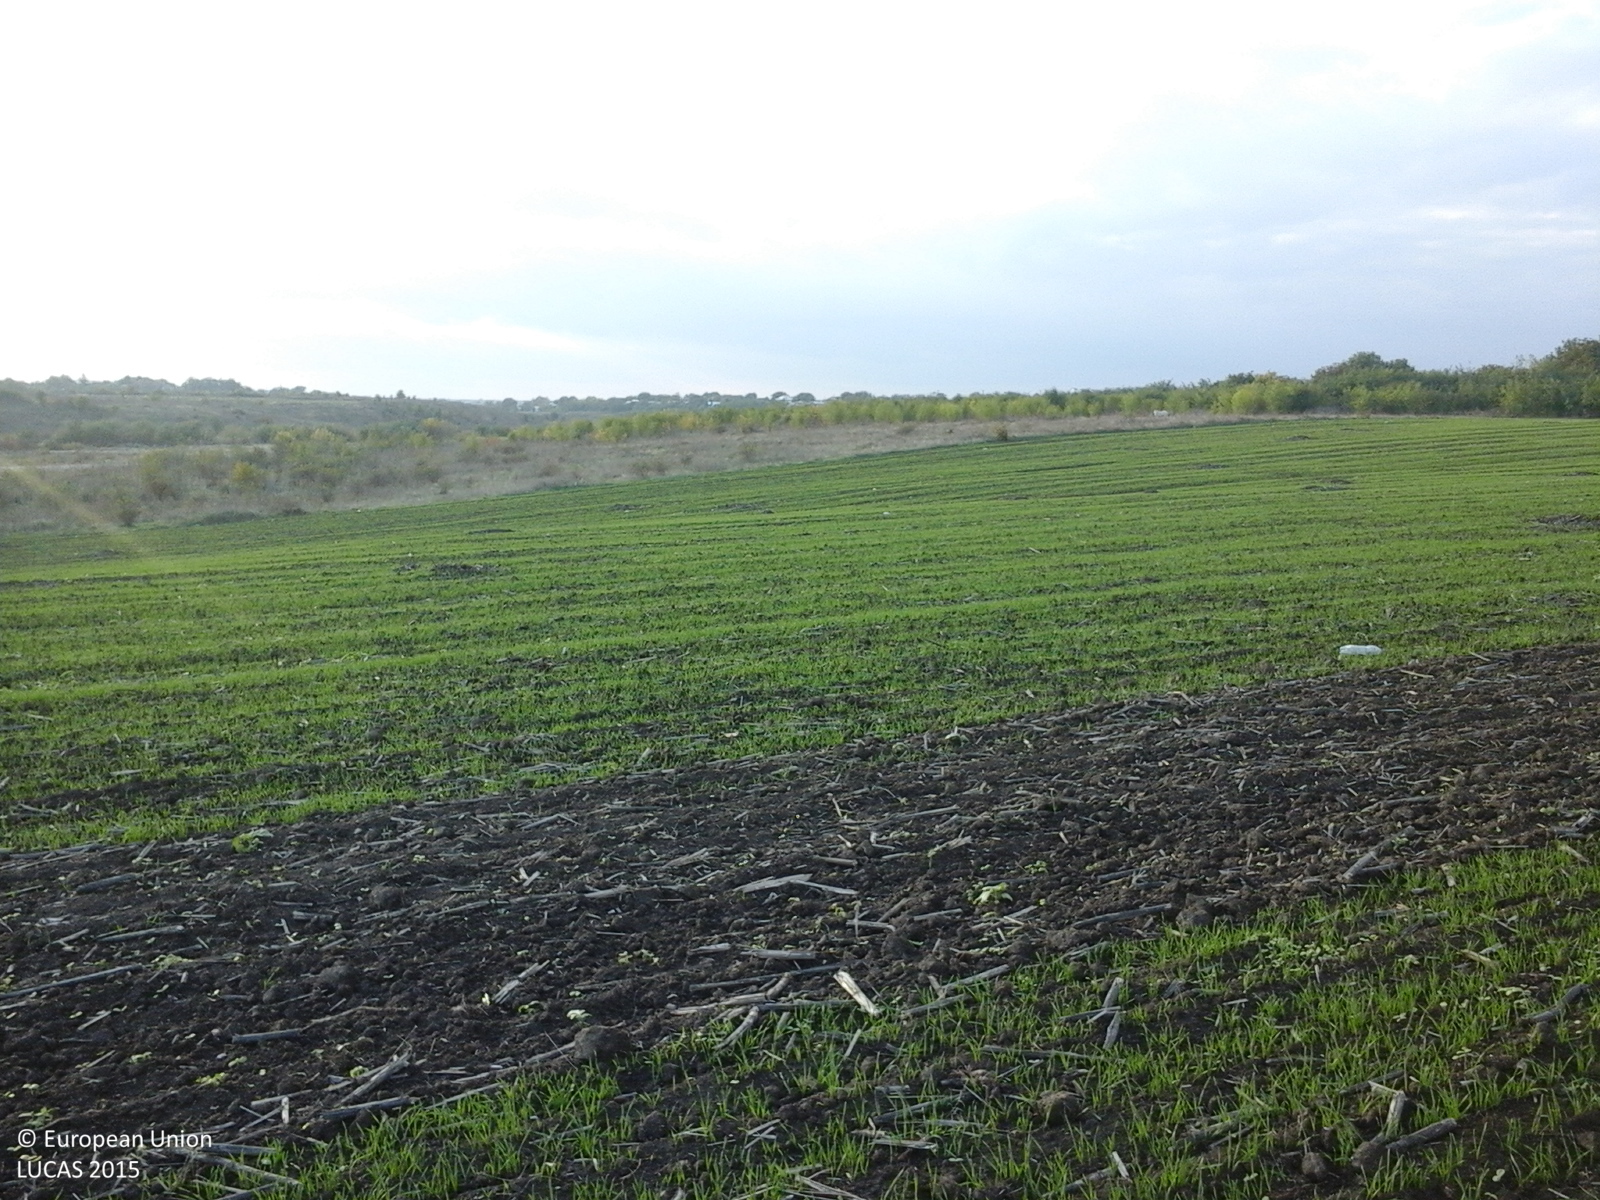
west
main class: Cropland
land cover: Common wheat
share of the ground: 25 - 50 %
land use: Agriculture (excluding fallow land and kitchen gardens)
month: October
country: RO
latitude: 44.6837
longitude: 25.9634
